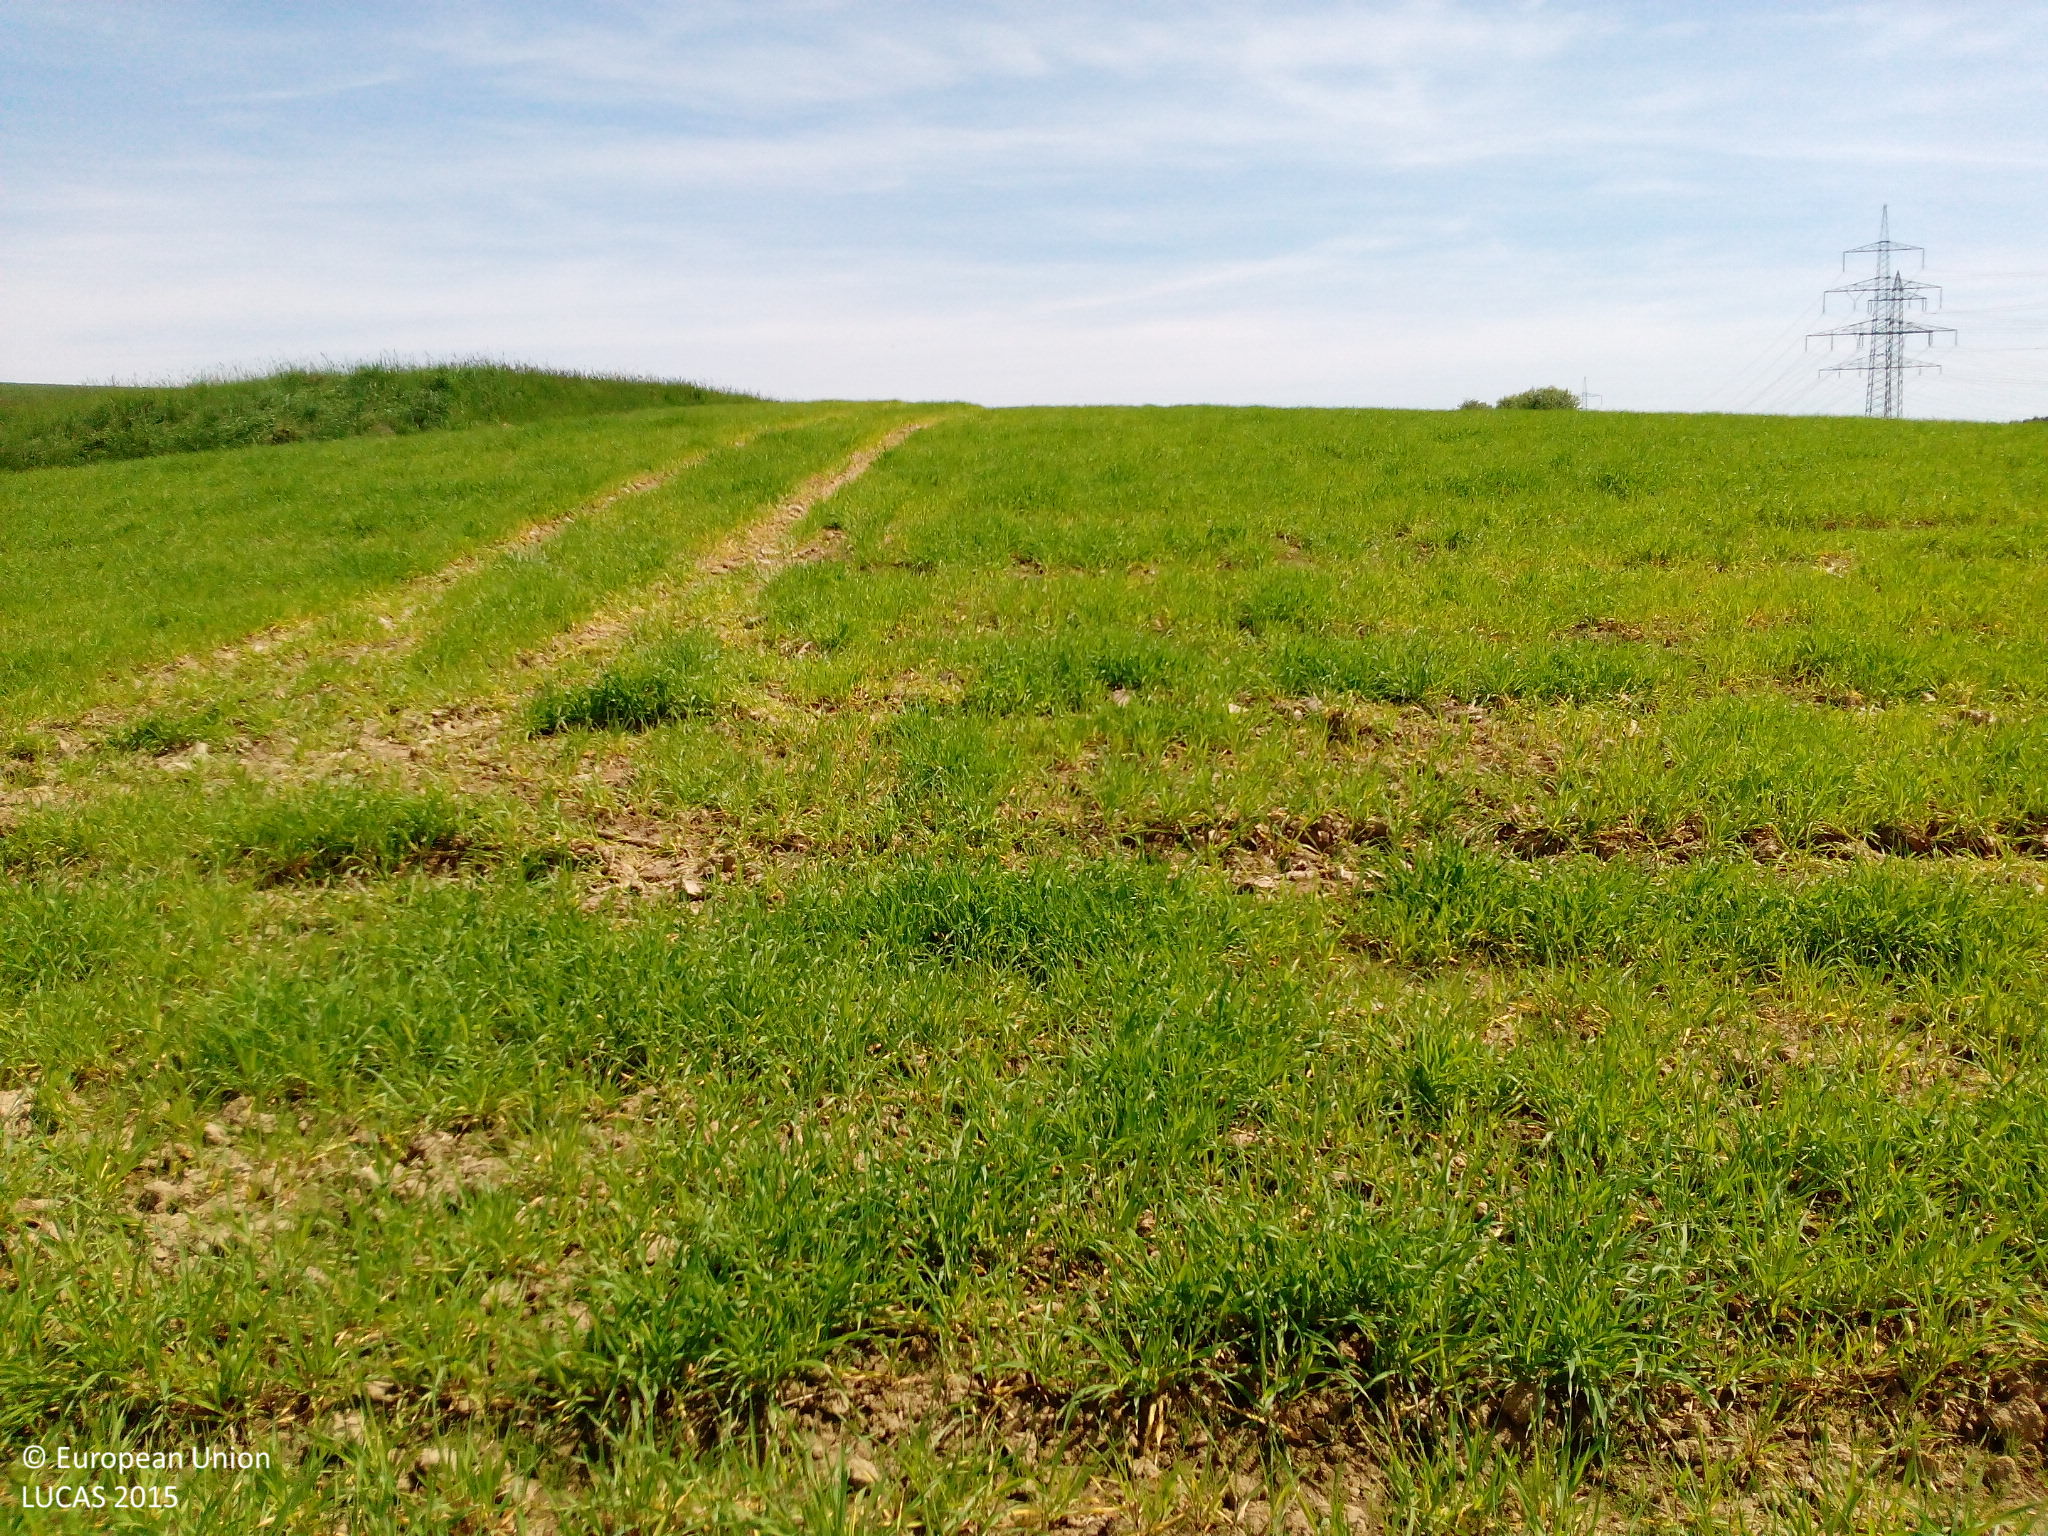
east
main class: Cropland
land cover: Barley
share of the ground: > 75 %
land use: Agriculture (excluding fallow land and kitchen gardens)
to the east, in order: Barley; Tracks; Common wheat; Oats
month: May
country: DE
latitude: 48.3217
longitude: 11.4693
